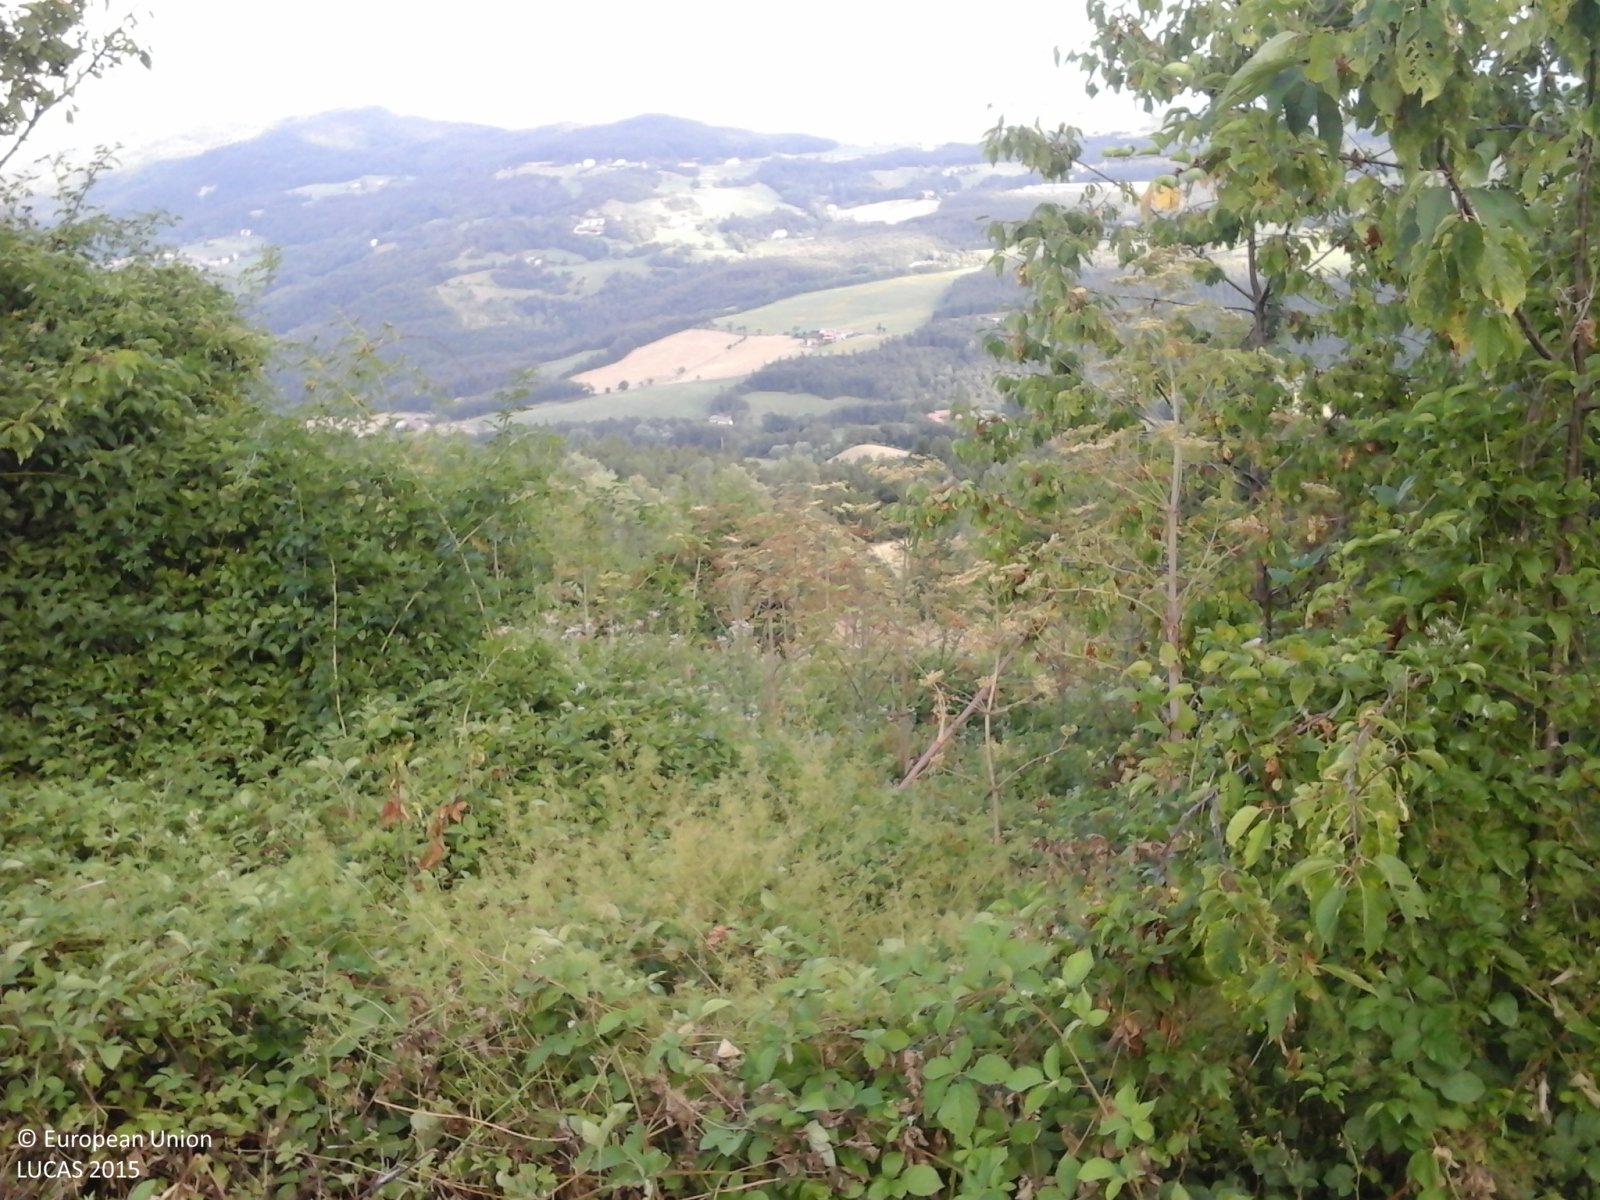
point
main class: Woodland
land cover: Broadleaved woodland
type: thermophilous deciduous forest
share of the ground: > 75 %
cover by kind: broadleaved forest trees 80 %, shrubs 10 %, herbaceous plants 10 %
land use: Forestry
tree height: > 5 m
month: July
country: IT
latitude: 44.2576
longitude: 10.7622
